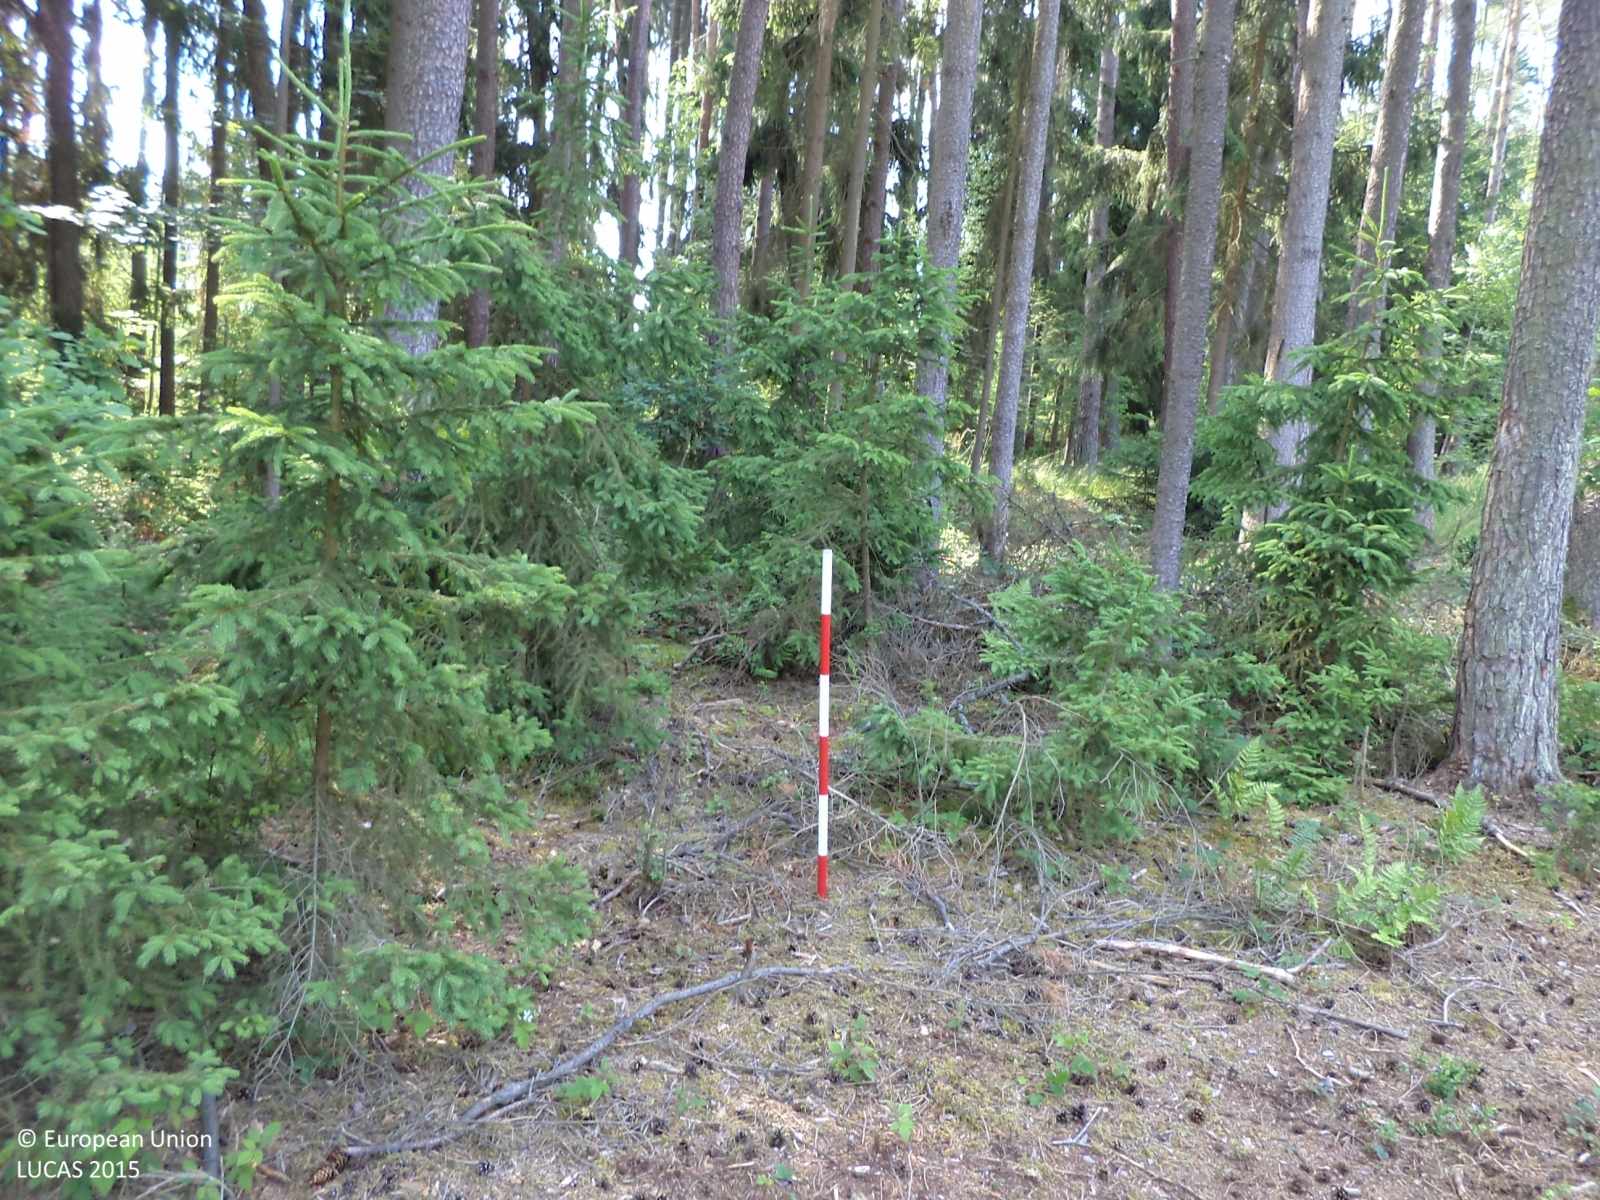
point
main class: Woodland
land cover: Pine dominated coniferous woodland
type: hemiboreal forest and nemoral coniferous forest and mixed broadleaved-coniferous forest
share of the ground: > 75 %
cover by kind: coniferous forest trees 90 %, herbaceous plants 10 %
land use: Forestry
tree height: > 5 m
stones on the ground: < 10 %
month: July
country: CZ
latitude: 49.3780
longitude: 14.4226
